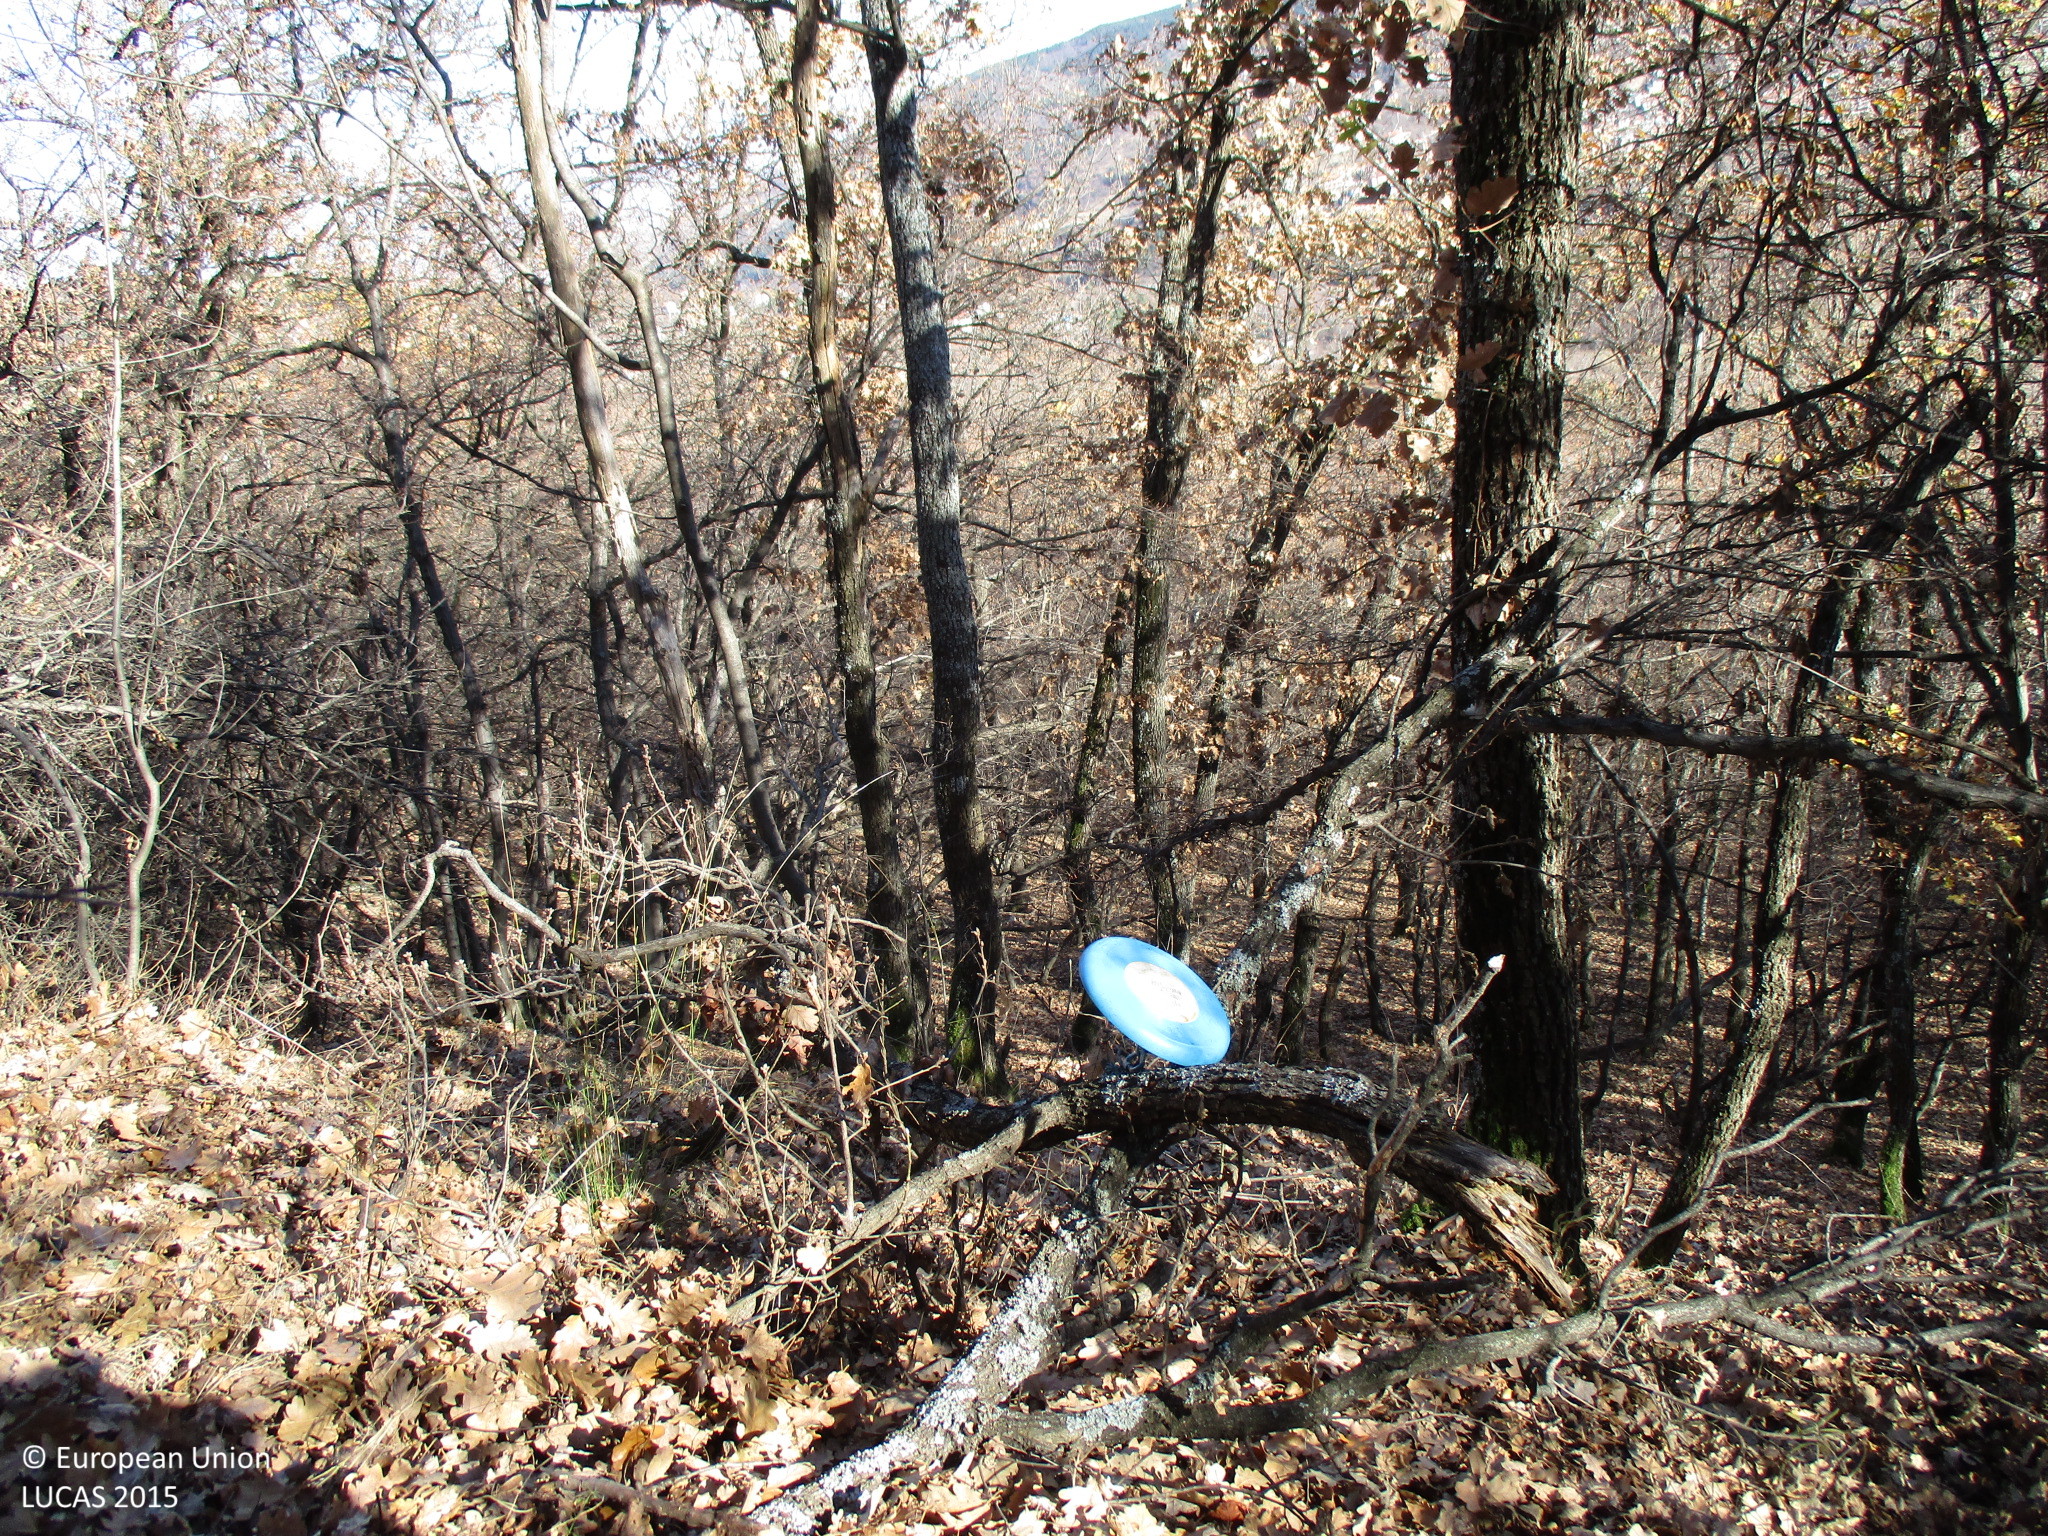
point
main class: Woodland
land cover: Broadleaved woodland
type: mesophytic deciduous forest
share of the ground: > 75 %
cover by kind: broadleaved forest trees 95 %, unconsolidated bare surface 5 %
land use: Forestry
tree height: > 5 m
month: December
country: BG
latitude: 42.0433
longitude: 24.6299
